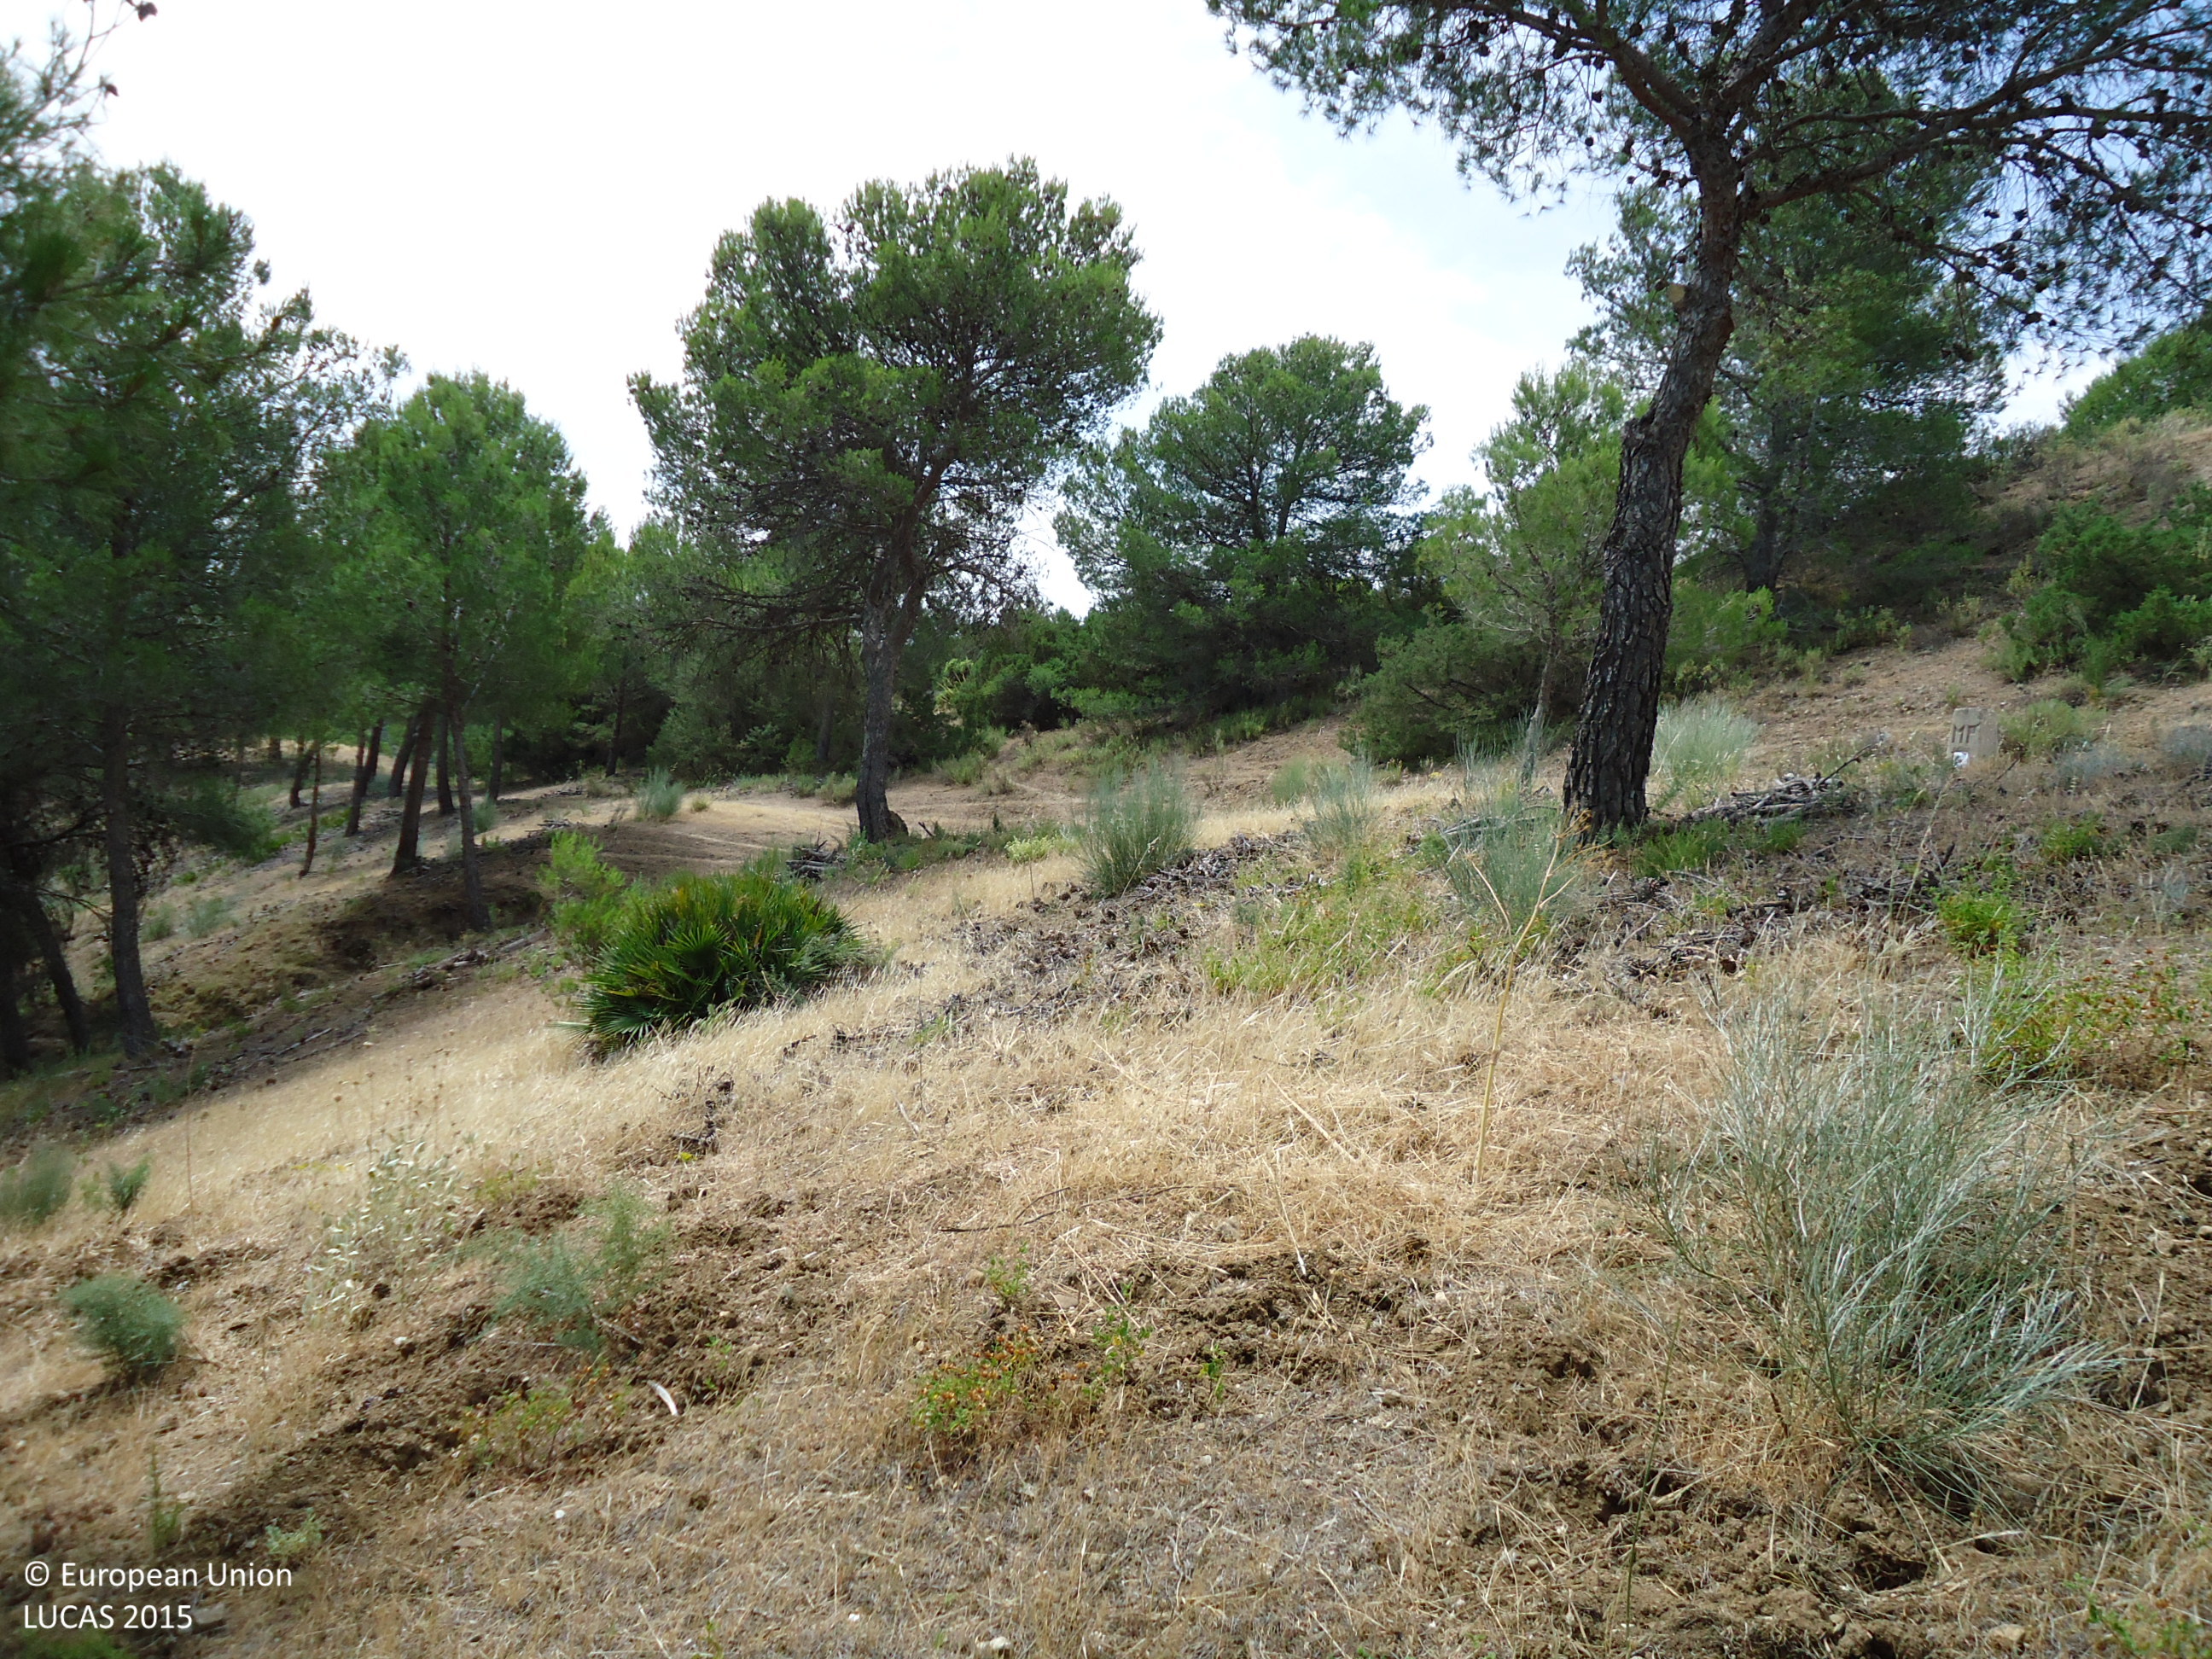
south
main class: Woodland
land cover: Pine dominated coniferous woodland
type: coniferous forest of the mediterranean region
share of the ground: > 75 %
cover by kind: coniferous forest trees 75 %, consolidated bare surface 20 %, shrubs 5 %
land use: Forestry
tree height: > 5 m
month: June
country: ES
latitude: 36.9134
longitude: -4.8026
